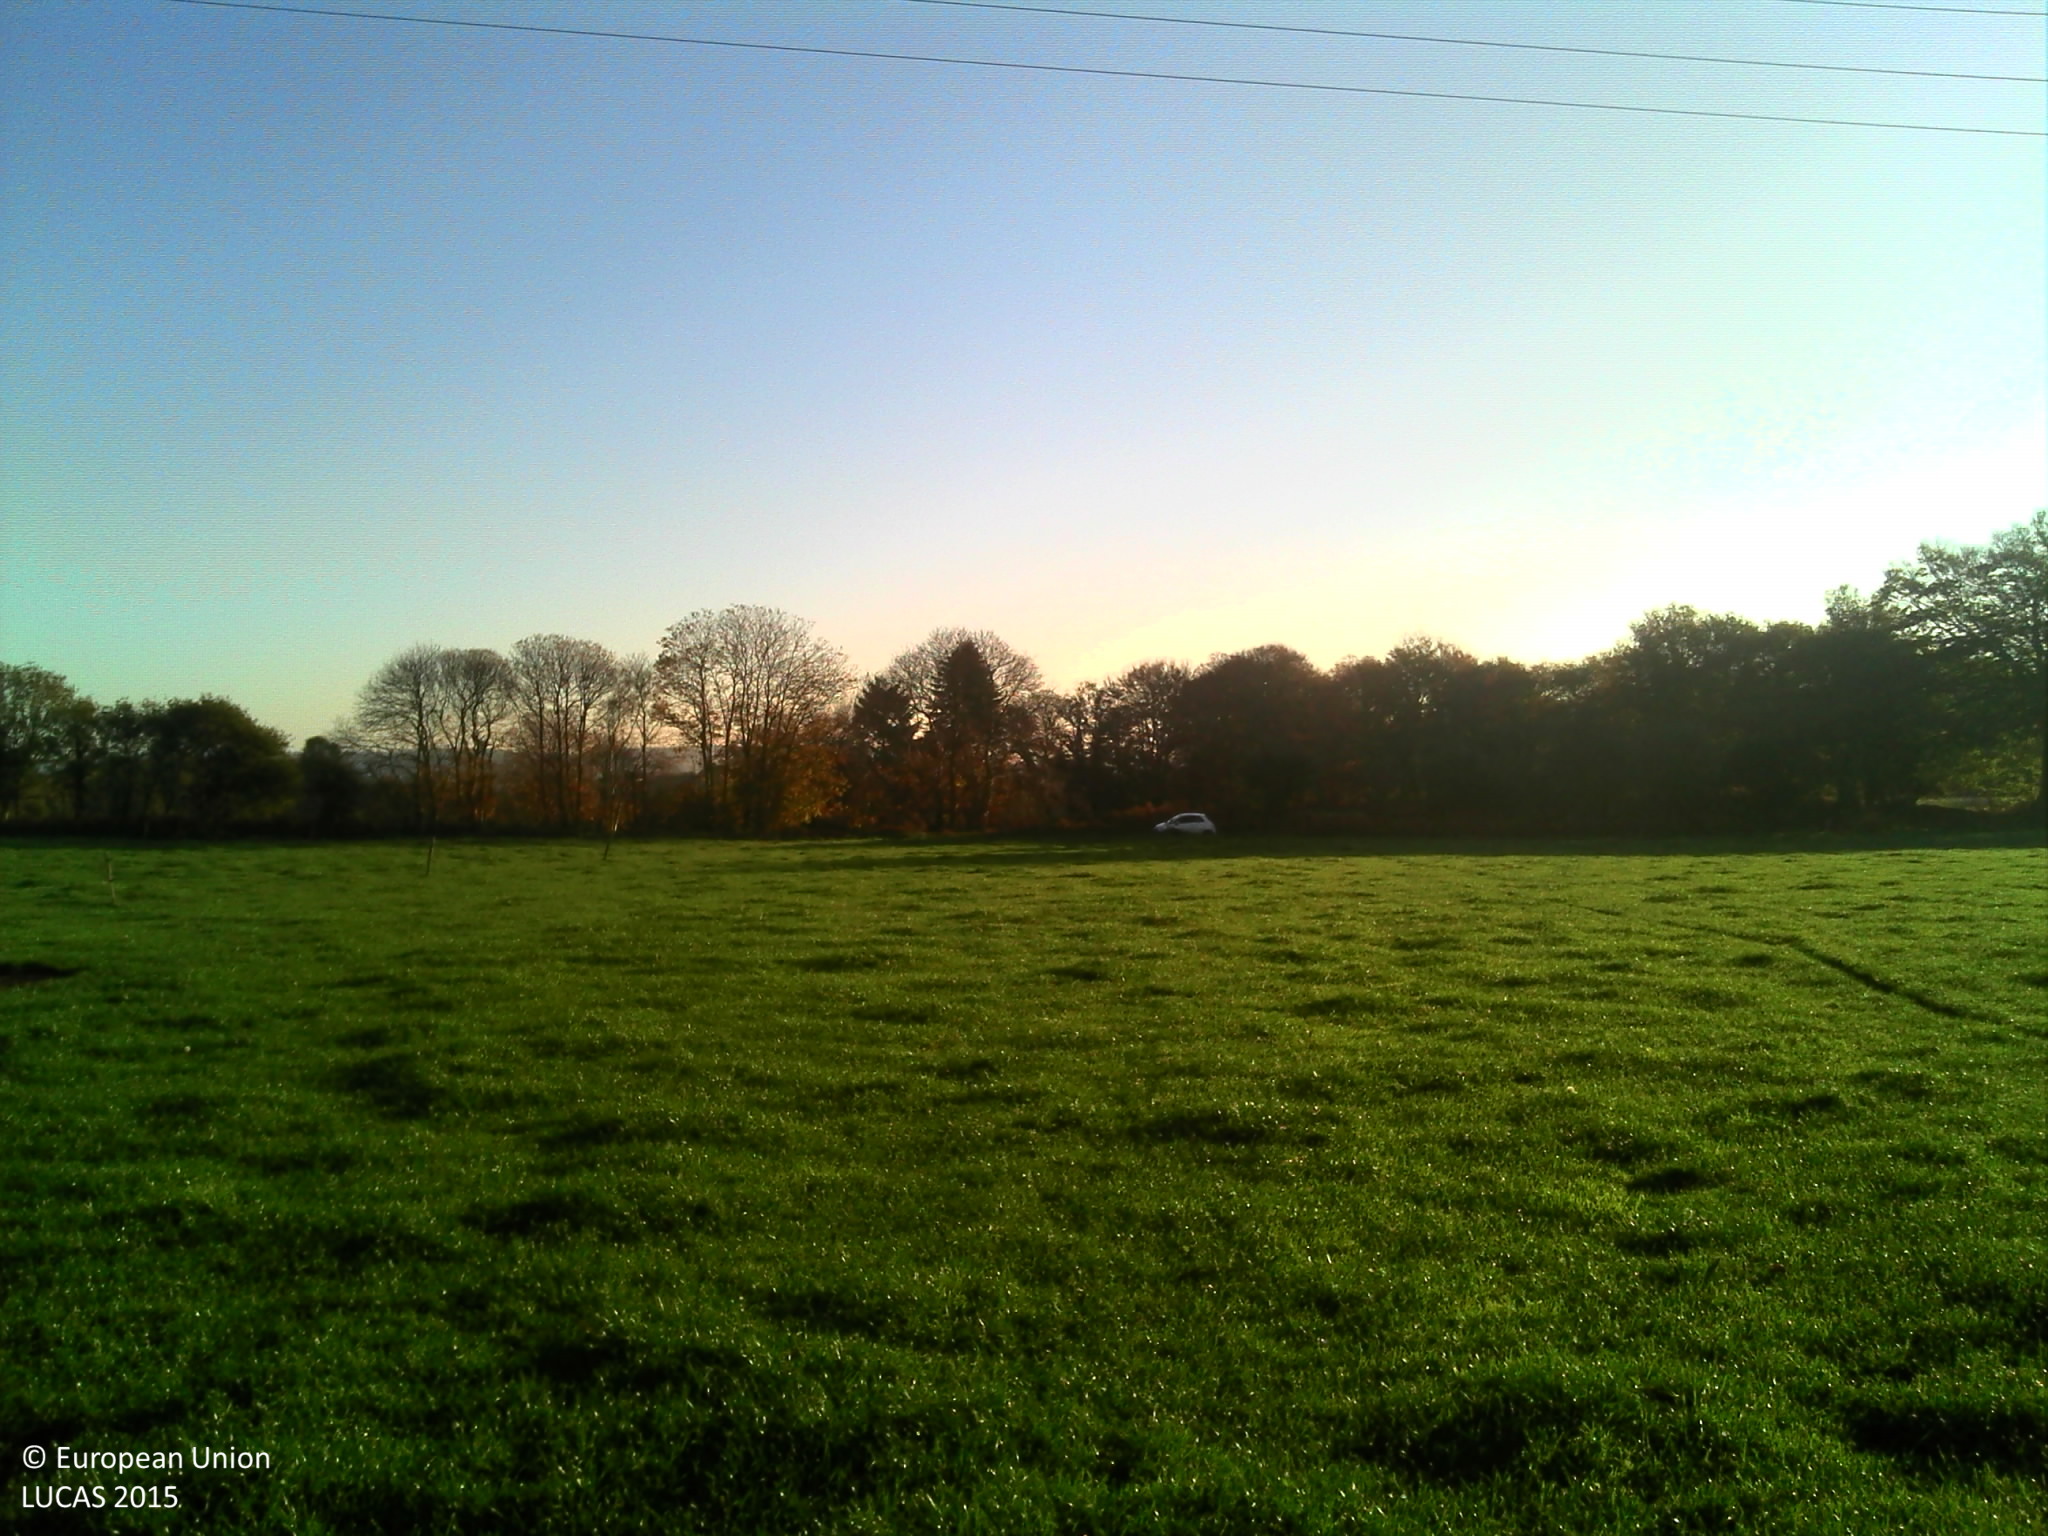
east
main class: Grassland
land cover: Grassland without tree/shrub cover
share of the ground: > 75 %
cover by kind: herbaceous plants 100 %
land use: Agriculture (excluding fallow land and kitchen gardens)
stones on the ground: < 10 %
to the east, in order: Grassland without tree/shrub cover; Electric lines; Grassland without tree/shrub cover; Fences; Ditches and canals; Grass margins; Tracks; Grass margins; Managed hedges; Grassland without tree/shrub cover; Broadleaved woodland; Fences; Spontaneously vegetated surfaces; Grassland without tree/shrub cover
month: November
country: FR
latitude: 48.1348
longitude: -3.3646
